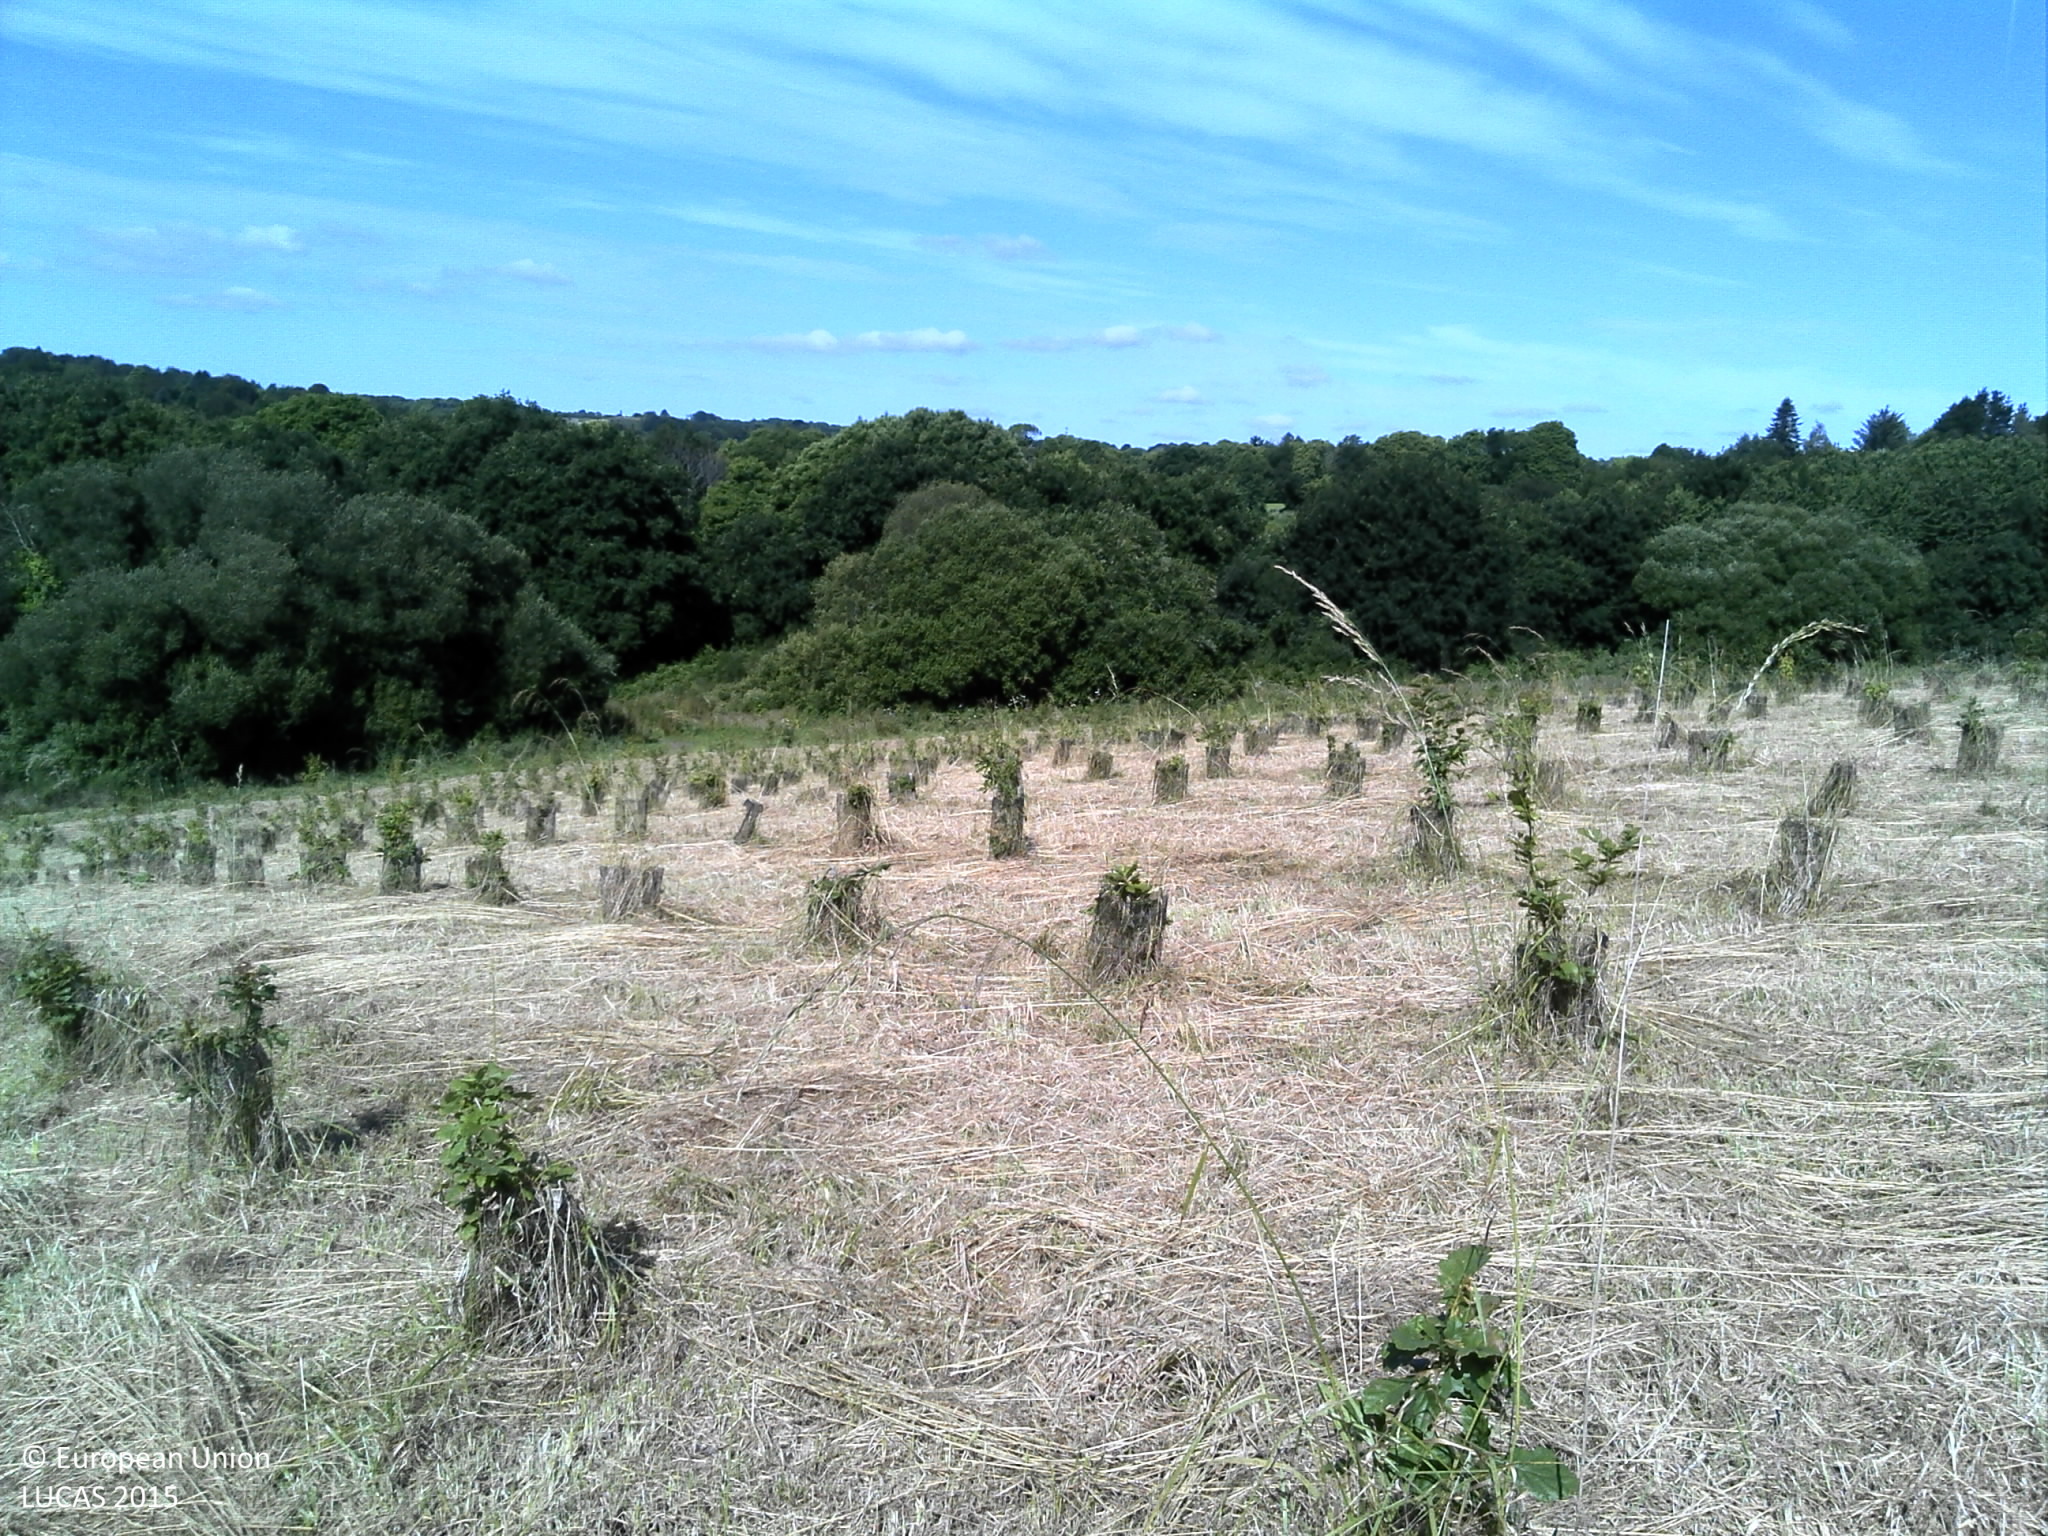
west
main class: Cropland
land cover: Nurseries
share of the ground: 50 - 75 %
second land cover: Spontaneously vegetated surfaces
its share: 50 - 75 %
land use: Agriculture (excluding fallow land and kitchen gardens)
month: June
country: FR
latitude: 47.9675
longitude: -4.1120
